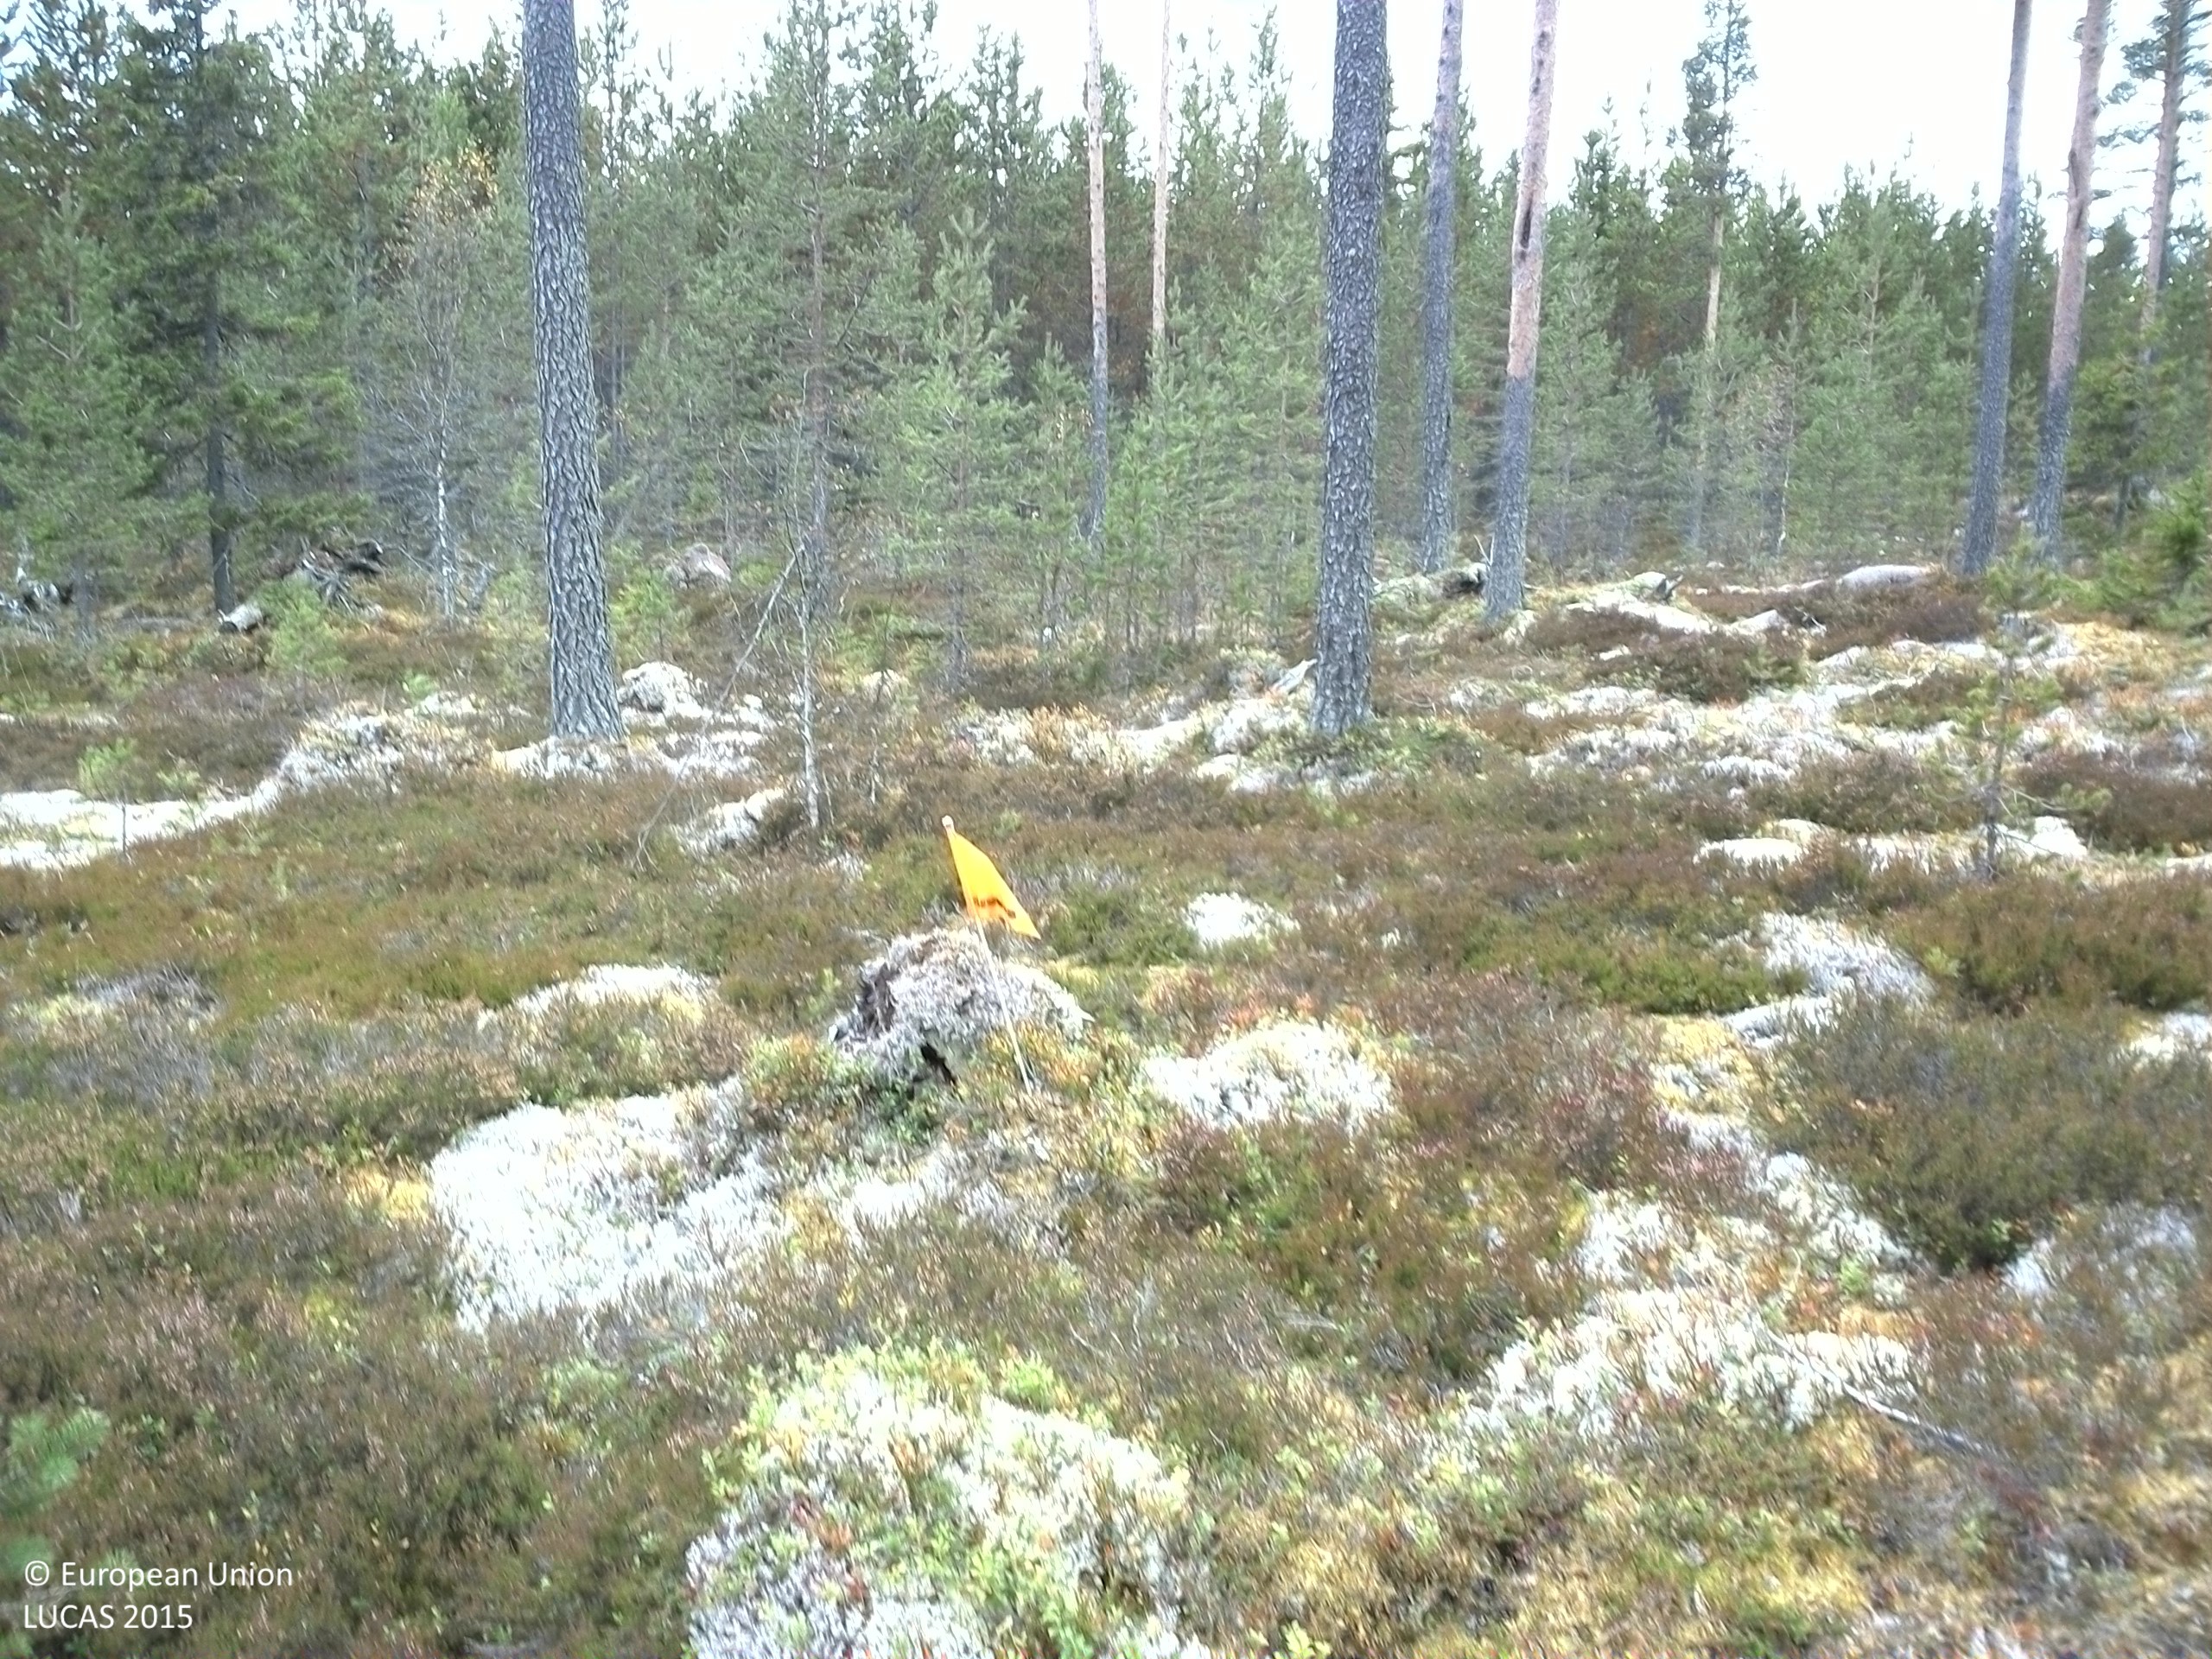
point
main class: Woodland
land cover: Pine dominated coniferous woodland
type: boreal forest
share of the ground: 25 - 50 %
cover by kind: shrubs 45 %, coniferous forest trees 35 %, lichens and mosses 20 %
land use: Forestry
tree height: > 5 m
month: October
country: SE
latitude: 61.5201
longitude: 14.3654
